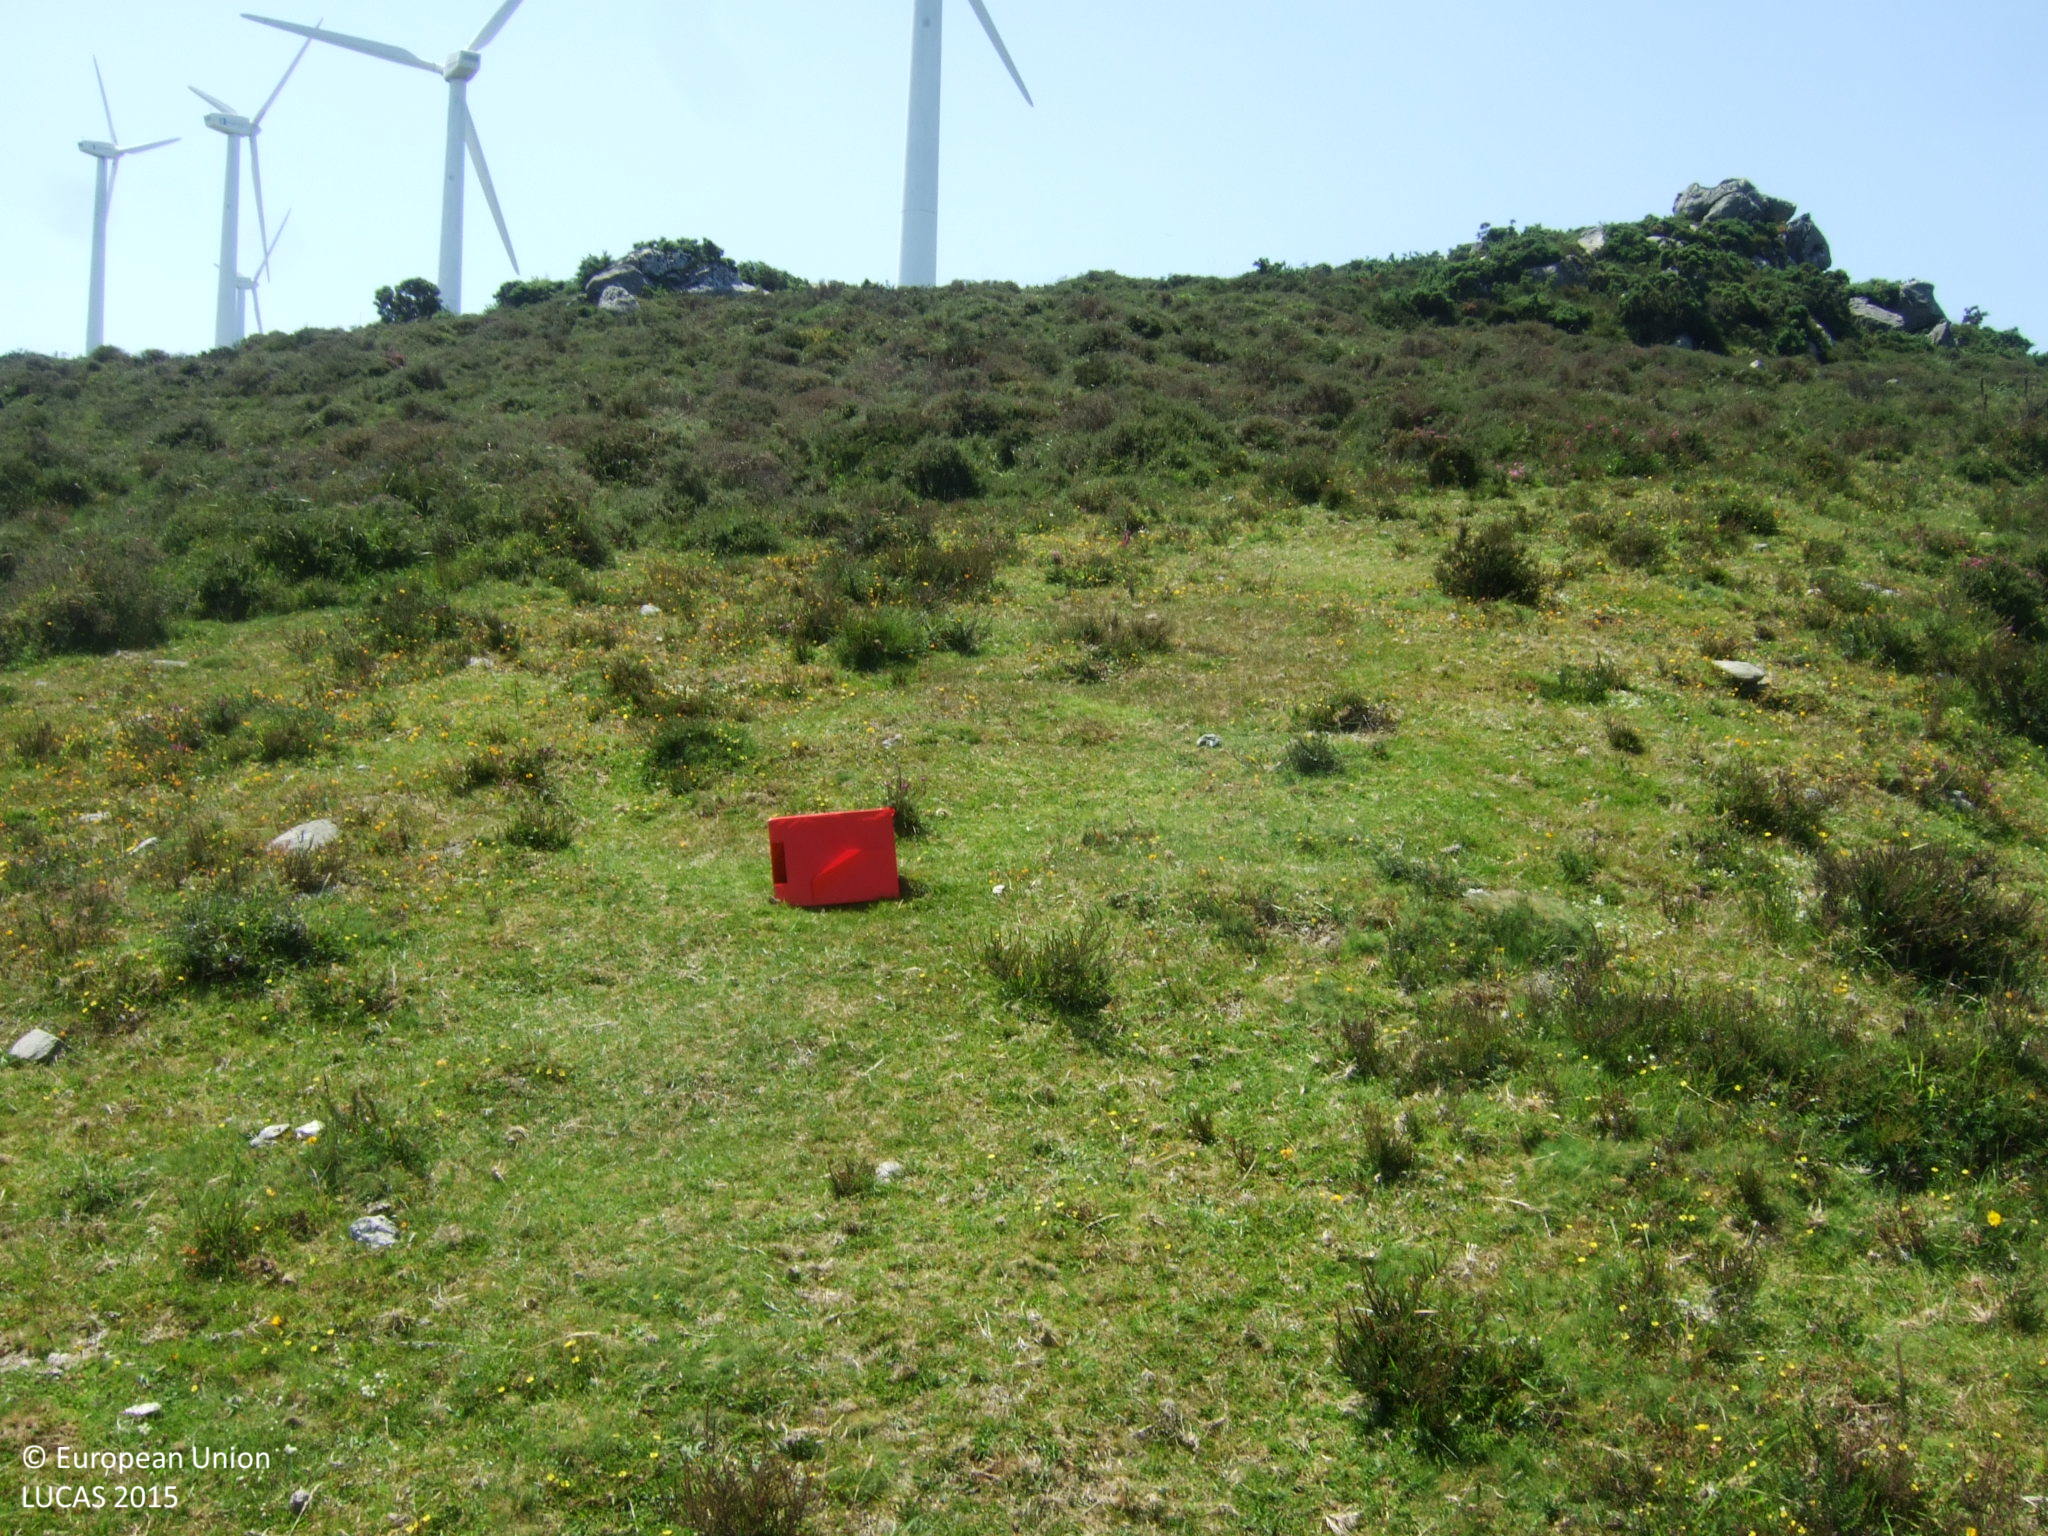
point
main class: Grassland
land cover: Grassland without tree/shrub cover
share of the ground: > 75 %
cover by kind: herbaceous plants 95 %, shrubs 5 %
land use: Agriculture (excluding fallow land and kitchen gardens)
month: June
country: ES
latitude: 43.5372
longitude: -7.5700
